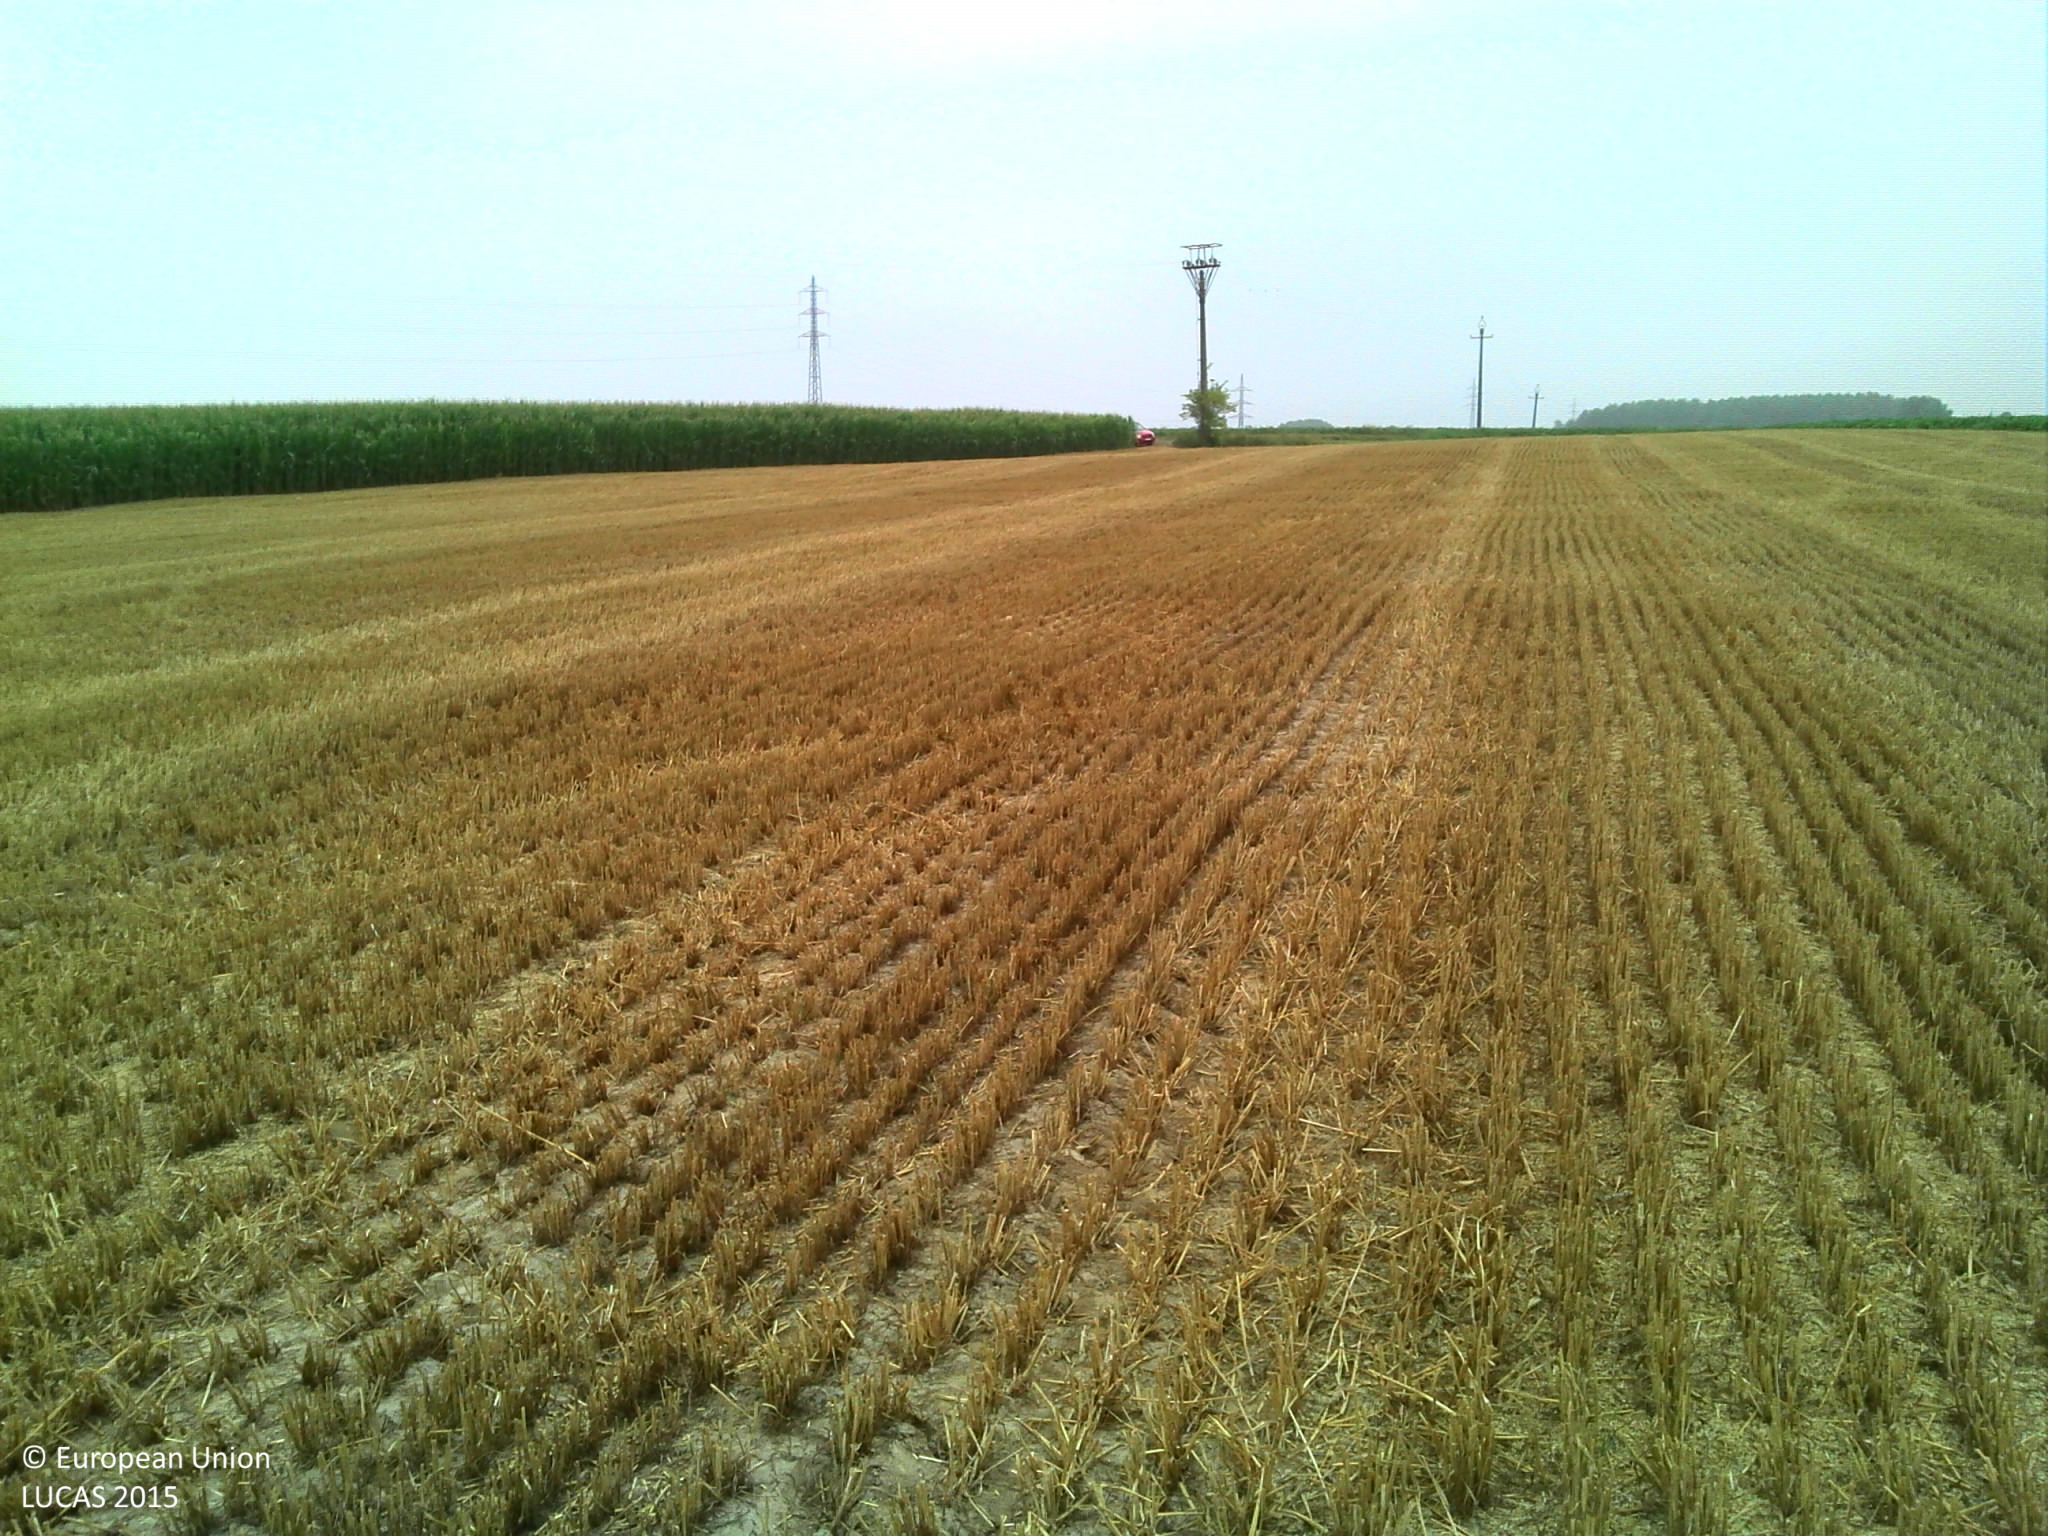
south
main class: Cropland
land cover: Common wheat
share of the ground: > 75 %
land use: Agriculture (excluding fallow land and kitchen gardens)
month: August
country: BE
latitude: 50.6351
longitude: 3.5877
